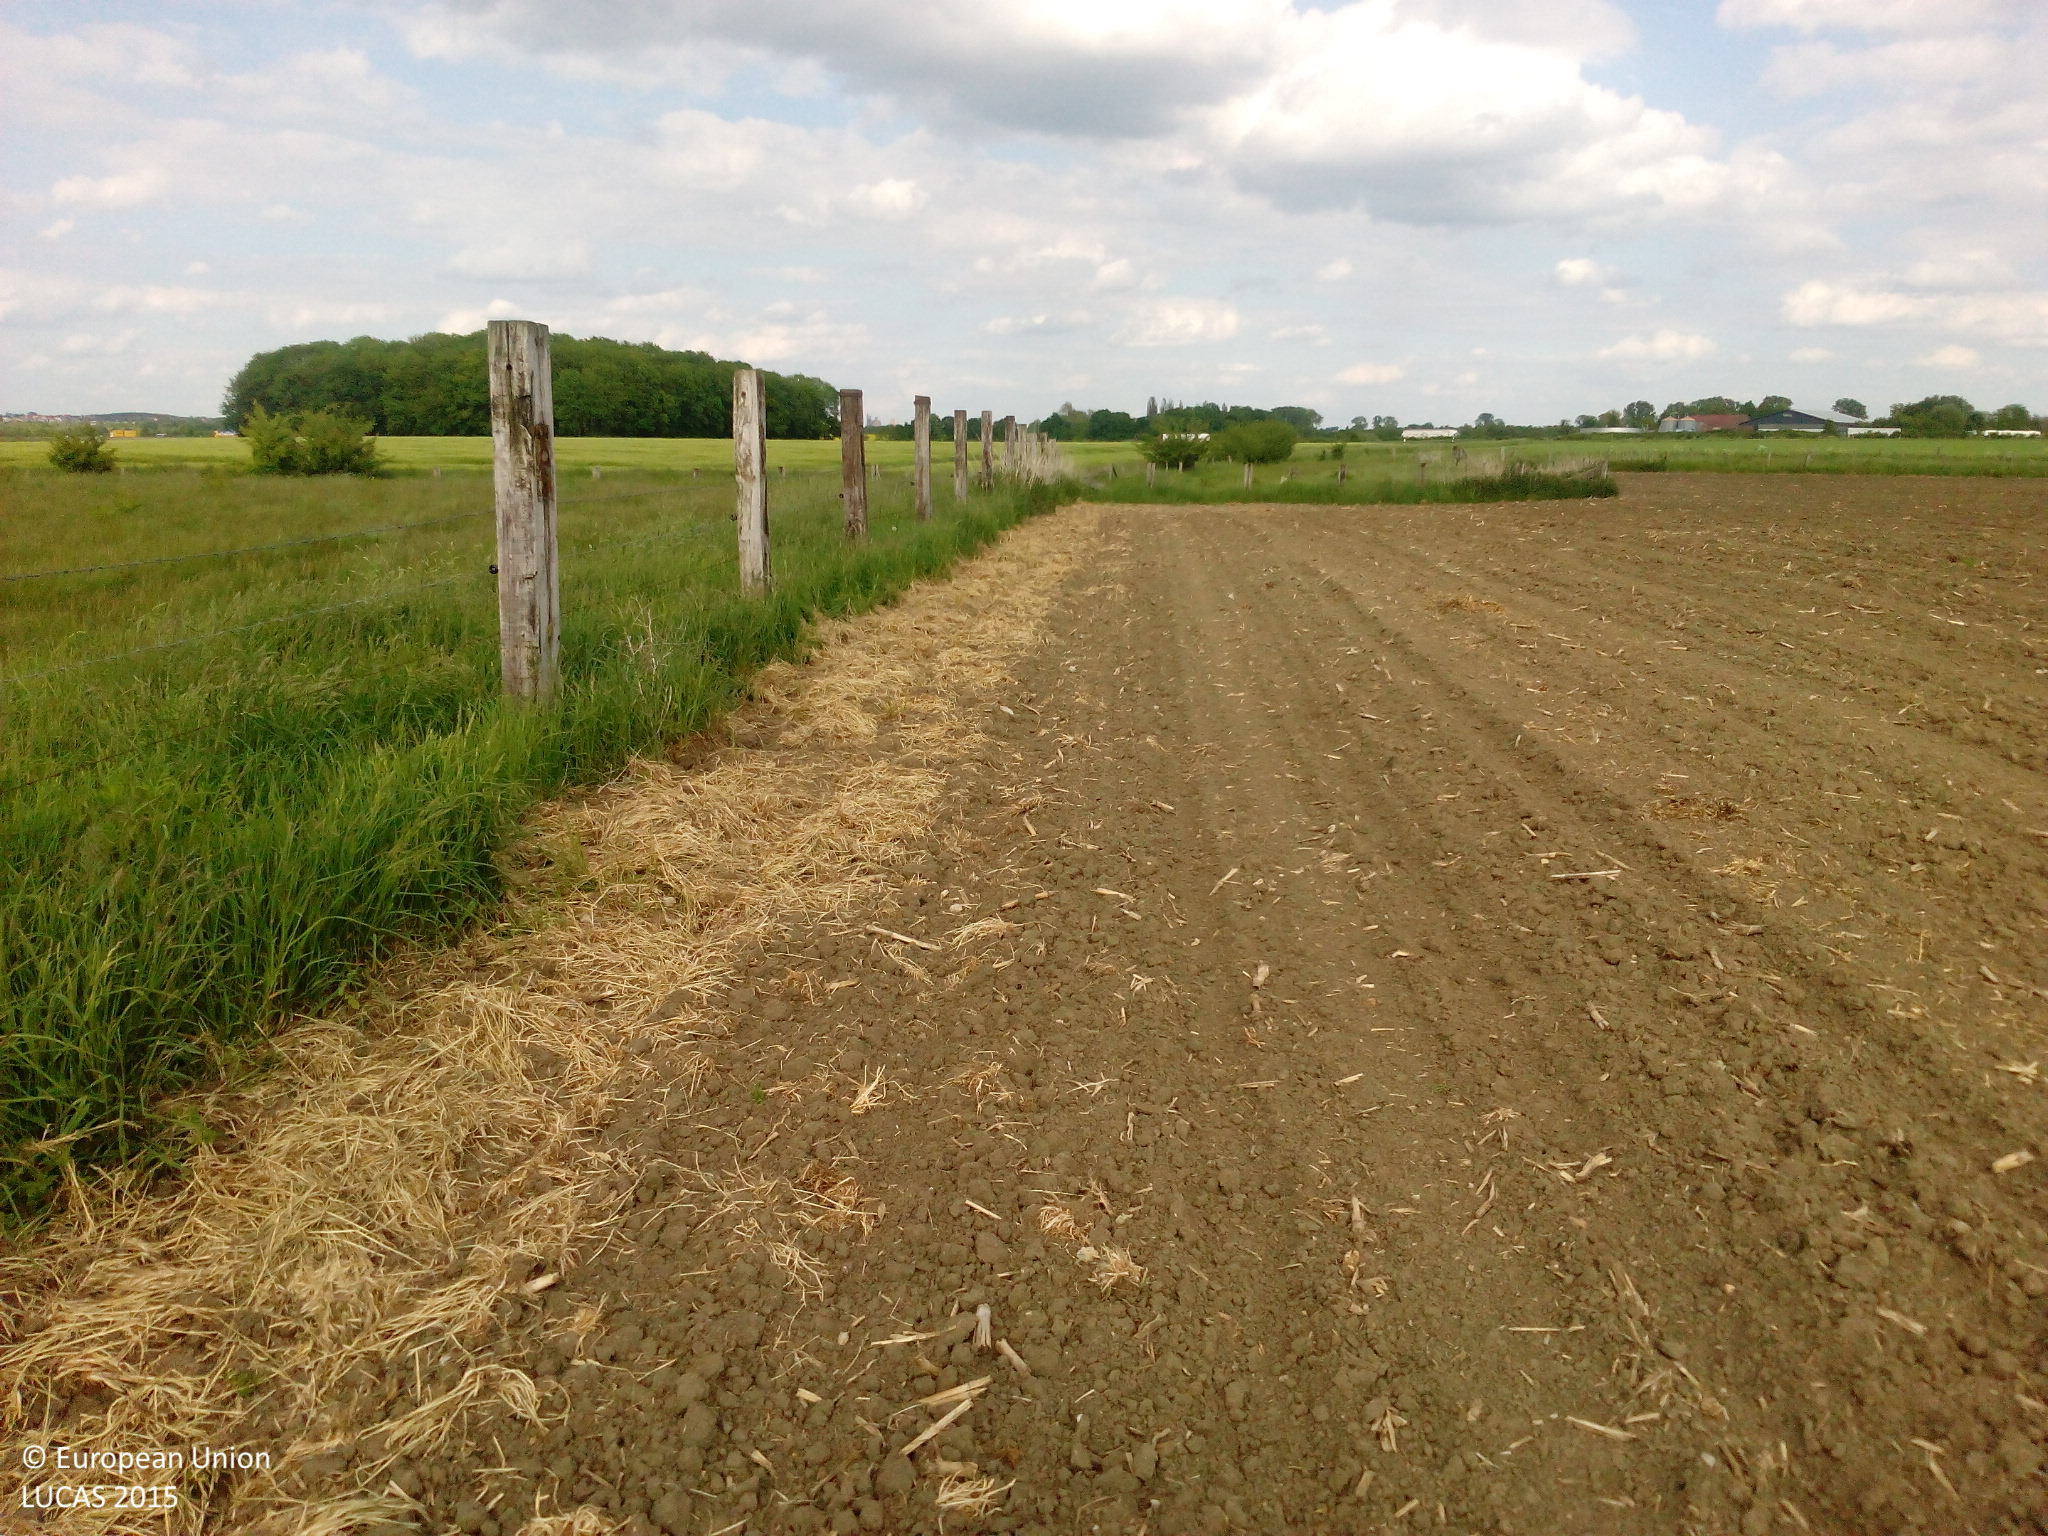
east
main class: Cropland
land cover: Maize
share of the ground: < 10 %
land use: Agriculture (excluding fallow land and kitchen gardens)
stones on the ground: < 10 %
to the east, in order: Maize; Fences; Grassland without tree/shrub cover; Fences; Abandoned hedges; Ditches and canals; Grass margins; Tracks; Barley; Maize
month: May
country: DE
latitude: 51.7491
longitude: 7.9870
